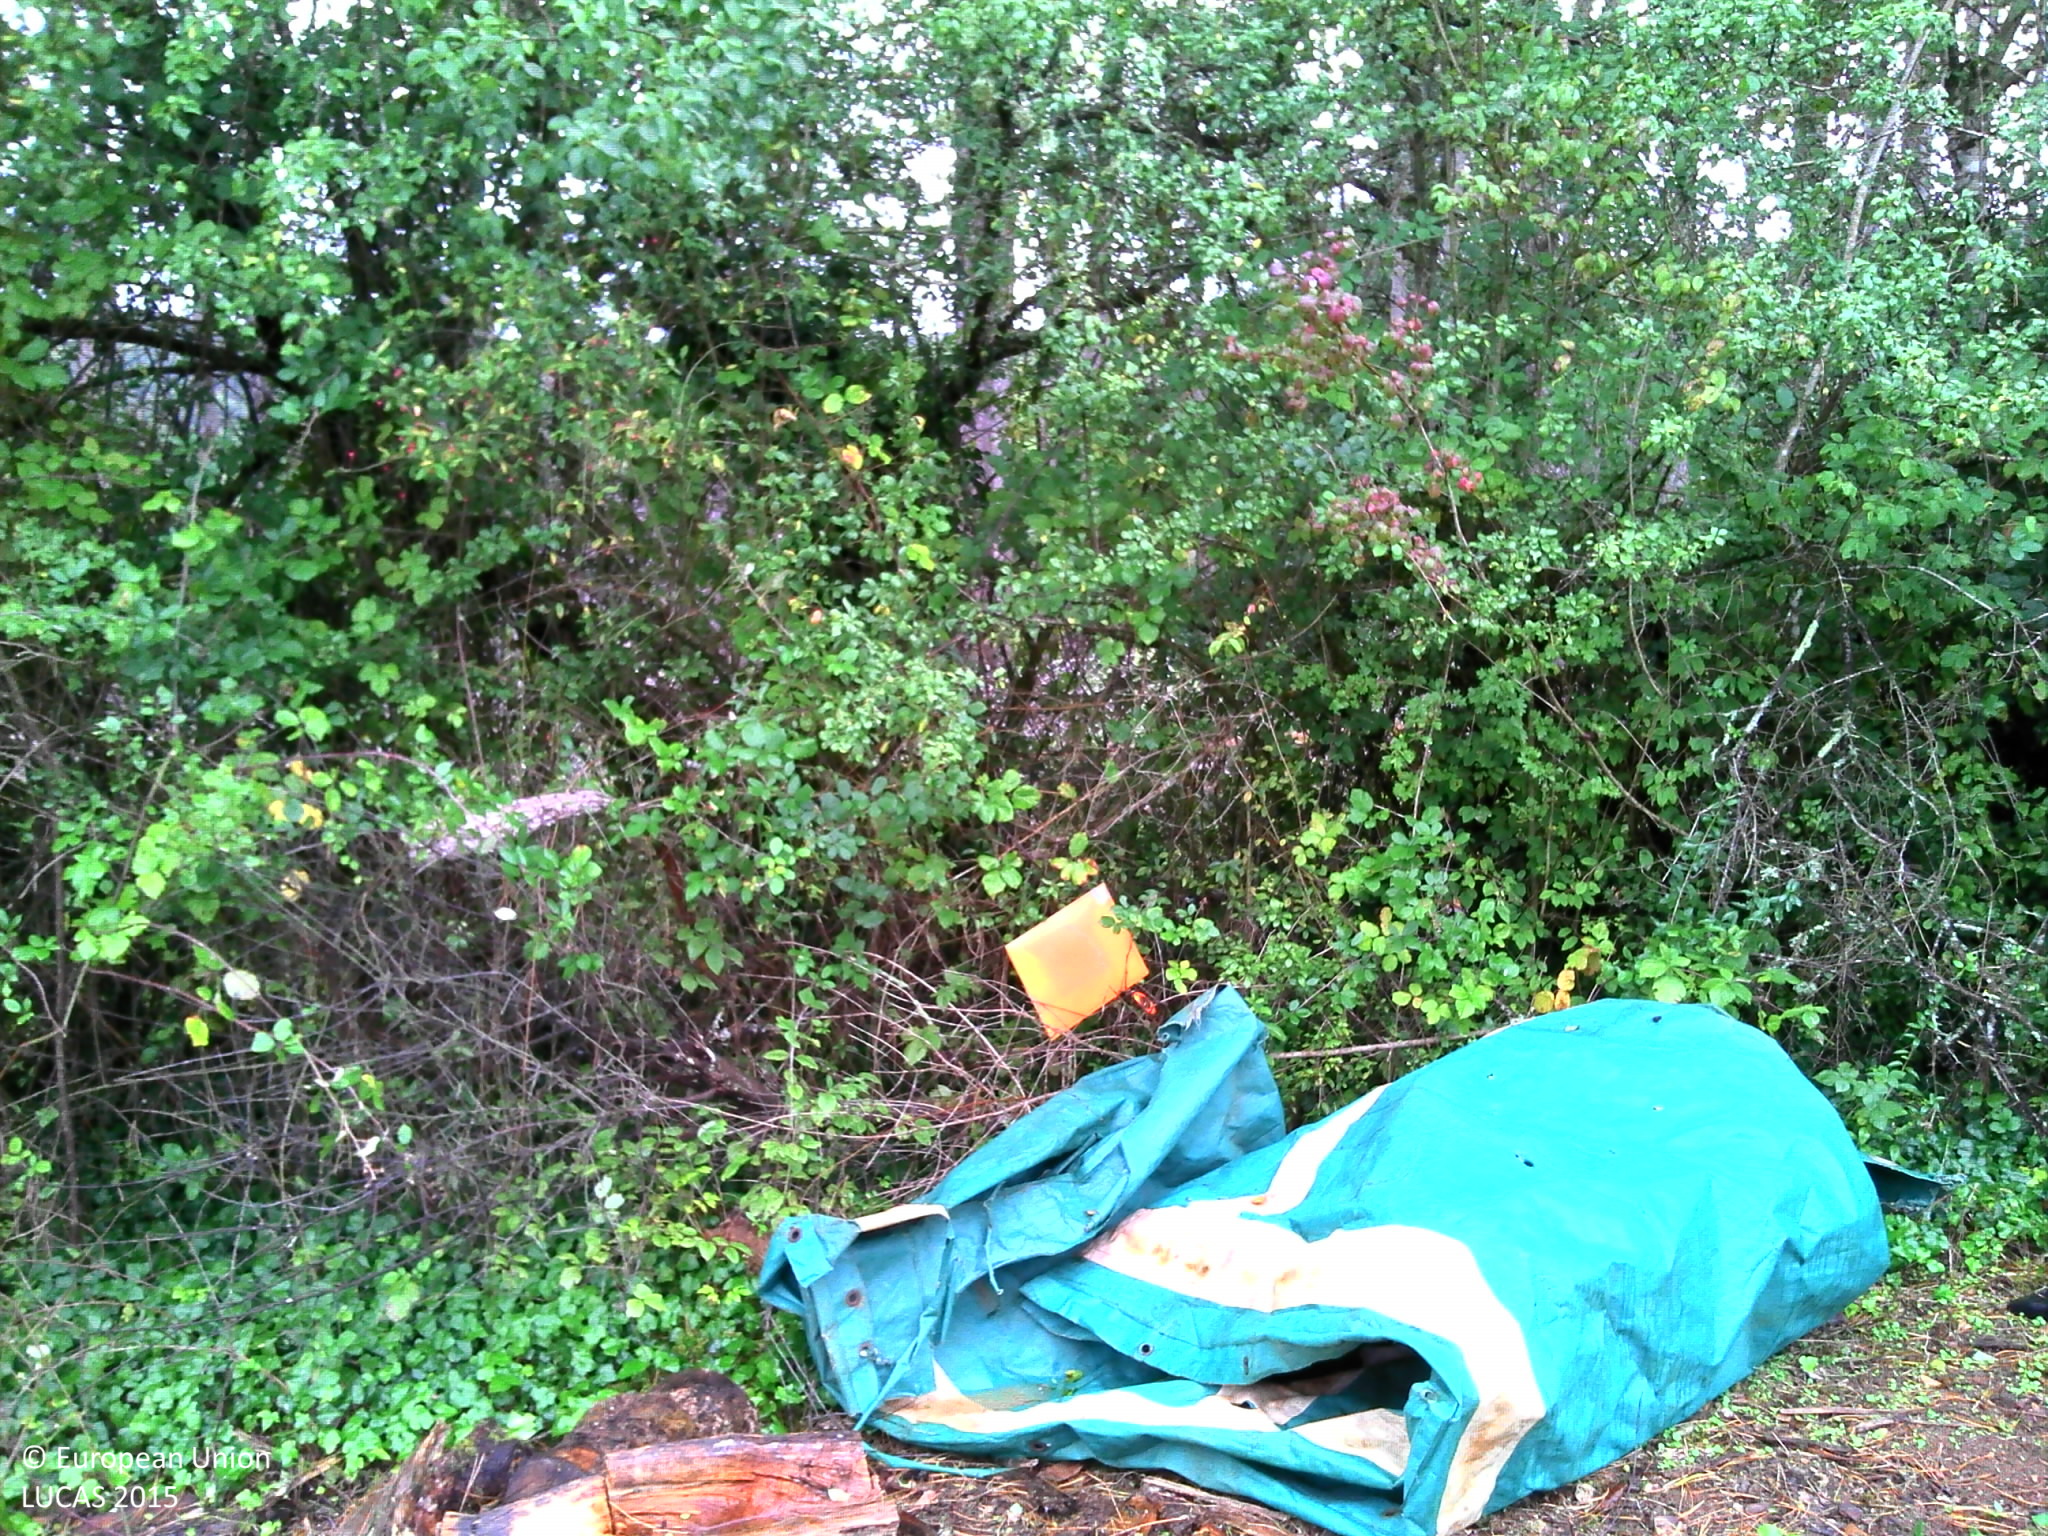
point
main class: Grassland
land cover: Grassland without tree/shrub cover
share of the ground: > 75 %
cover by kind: herbaceous plants 100 %
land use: Agriculture (excluding fallow land and kitchen gardens)
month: September
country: FR
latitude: 47.0728
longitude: 4.7988
